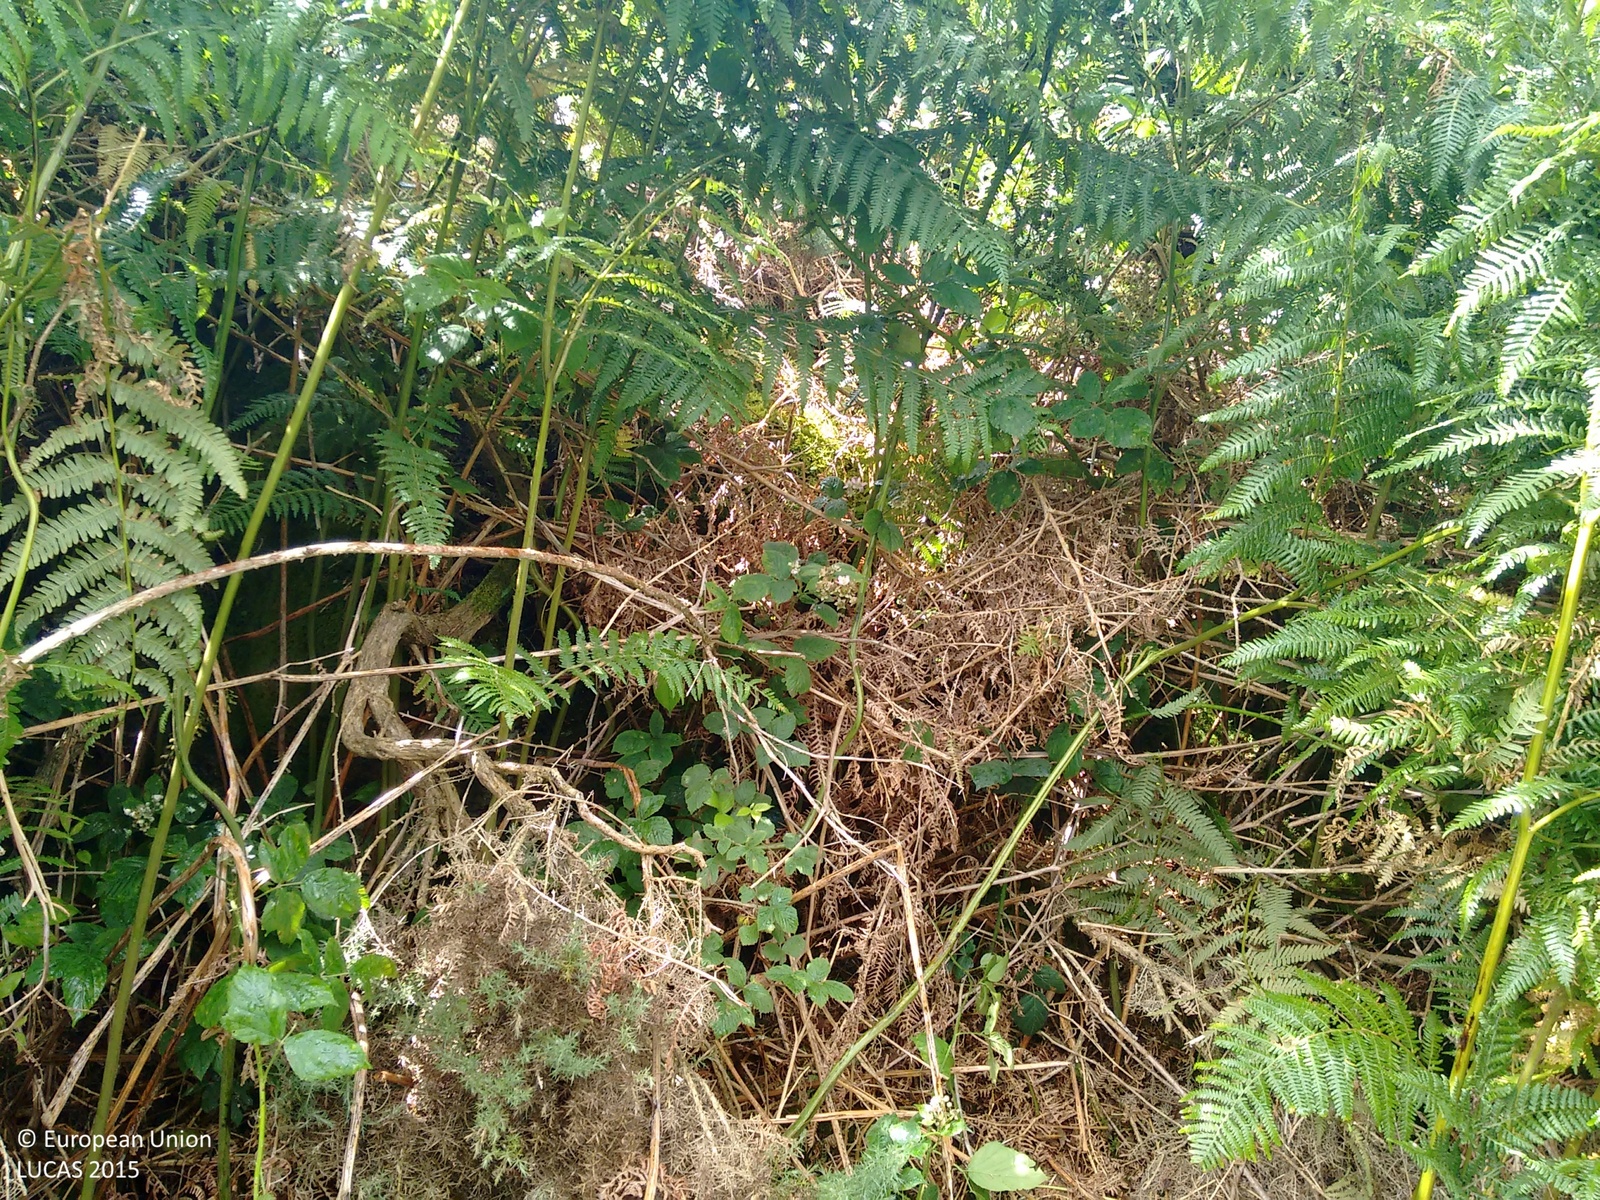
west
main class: Shrubland
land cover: Shrubland without tree cover
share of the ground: > 75 %
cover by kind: shrubs 100 %
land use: Semi-natural and natural areas not in use
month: August
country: IE
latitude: 54.0294
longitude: -6.3179
